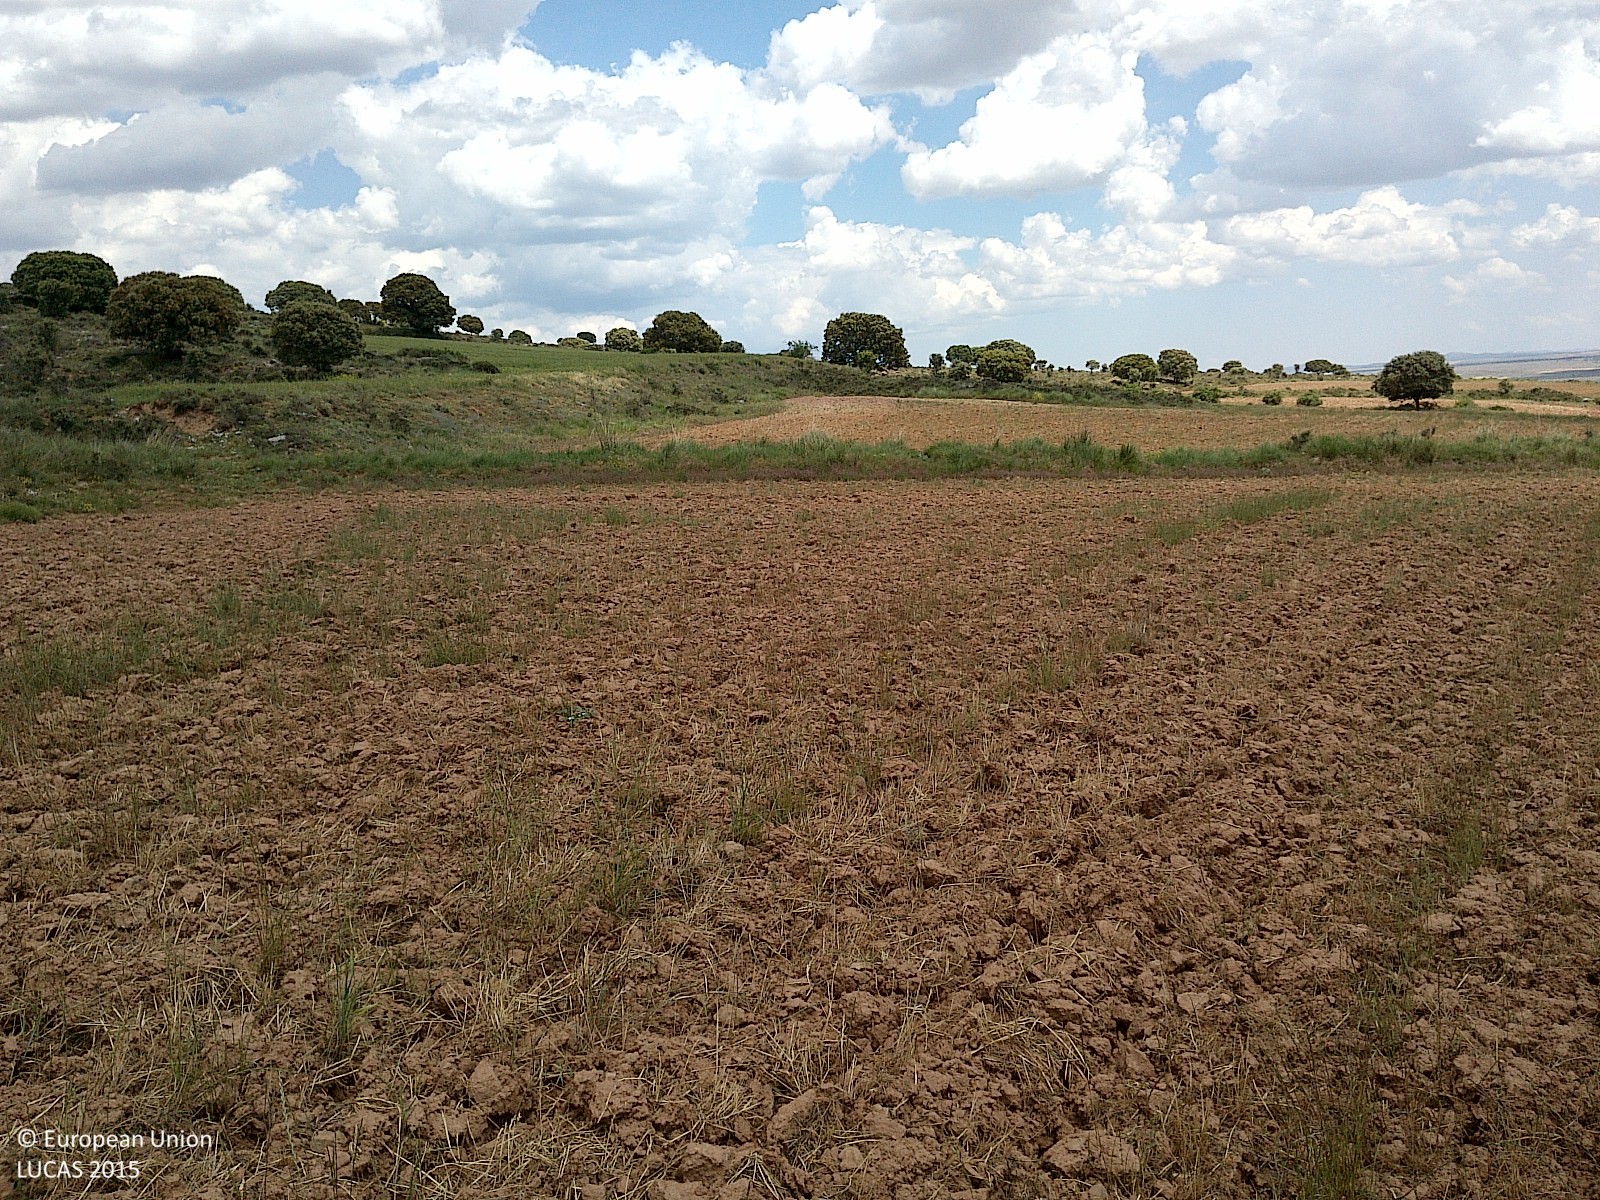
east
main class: Grassland
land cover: Spontaneously vegetated surfaces
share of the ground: 10 - 25 %
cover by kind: unconsolidated bare surface 80 %, herbaceous plants 20 %
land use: Fallow land
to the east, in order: Spontaneously vegetated surfaces; Grass margins; Spontaneously vegetated surfaces; Grassland without tree/shrub cover; Common wheat; Dry stone walls; Shrubland with sparse tree cover; Shrubland without tree cover; Dry stone walls; Shrubland without tree cover
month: June
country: ES
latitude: 41.7531
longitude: -2.1692
